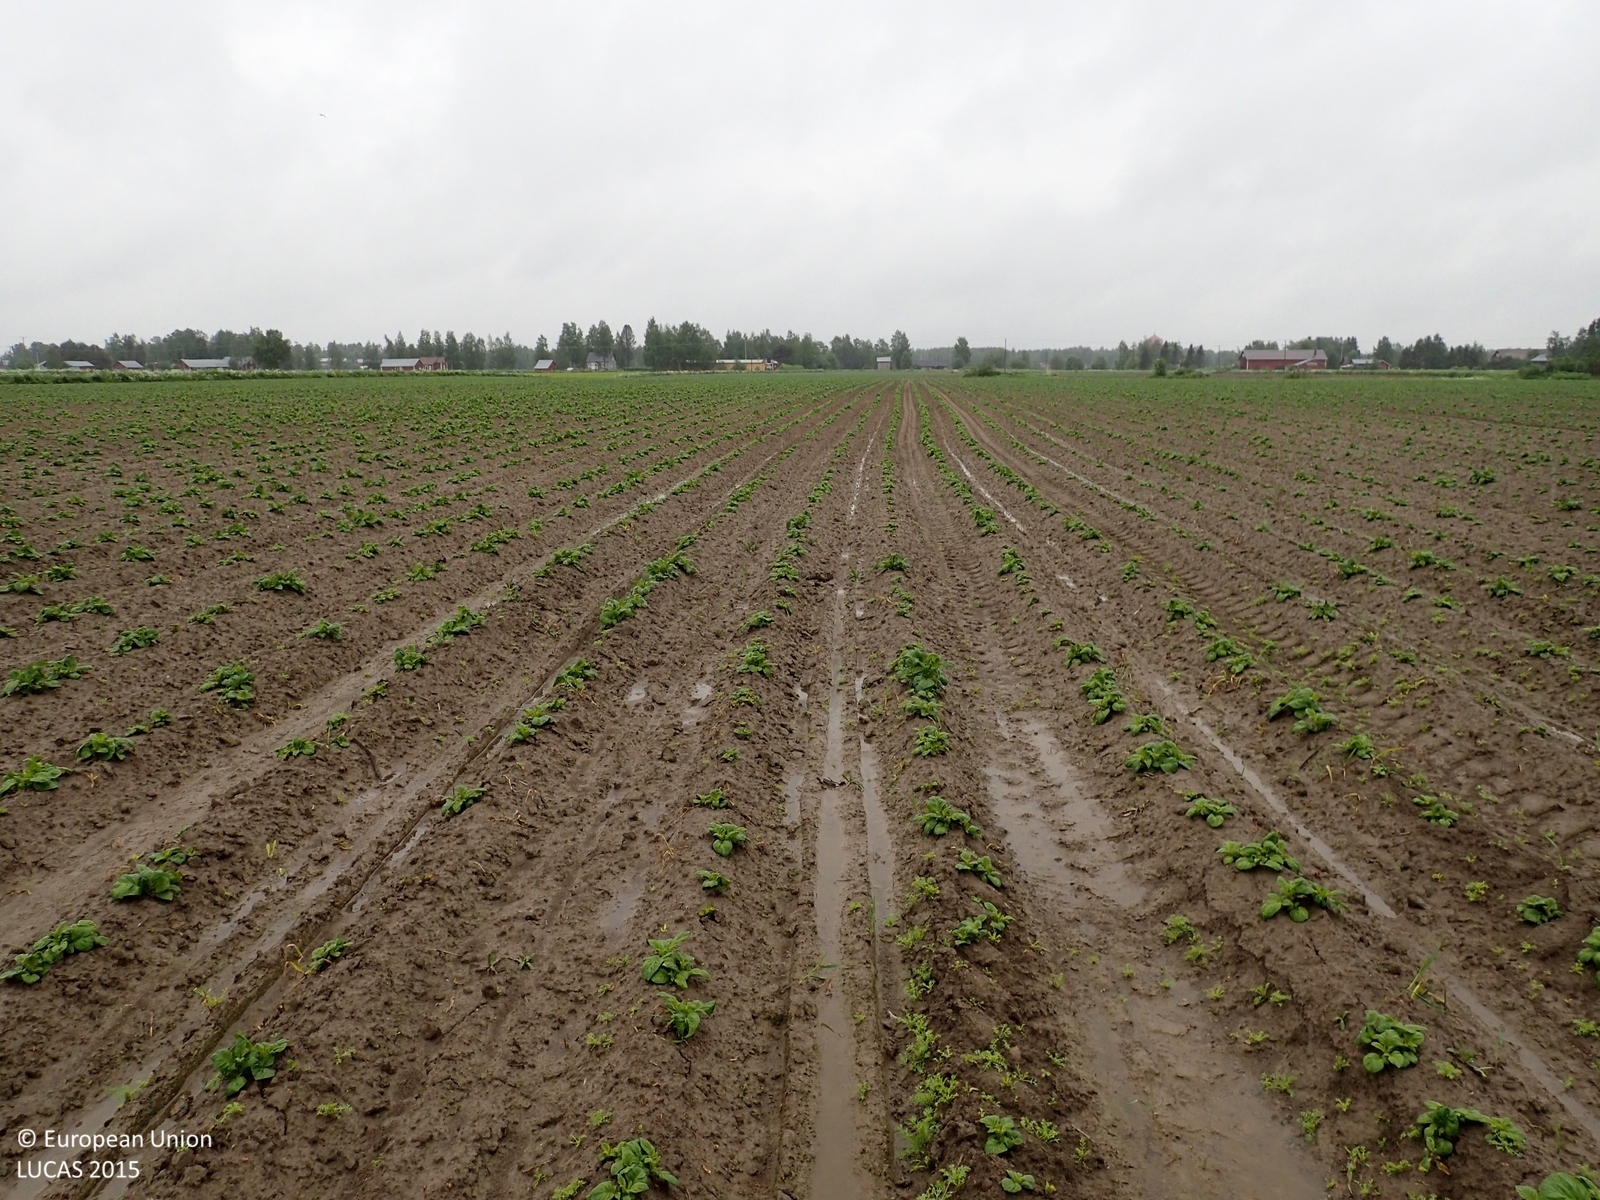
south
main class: Cropland
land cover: Potatoes
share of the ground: 10 - 25 %
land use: Agriculture (excluding fallow land and kitchen gardens)
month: June
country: FI
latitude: 62.2583
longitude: 21.5420
